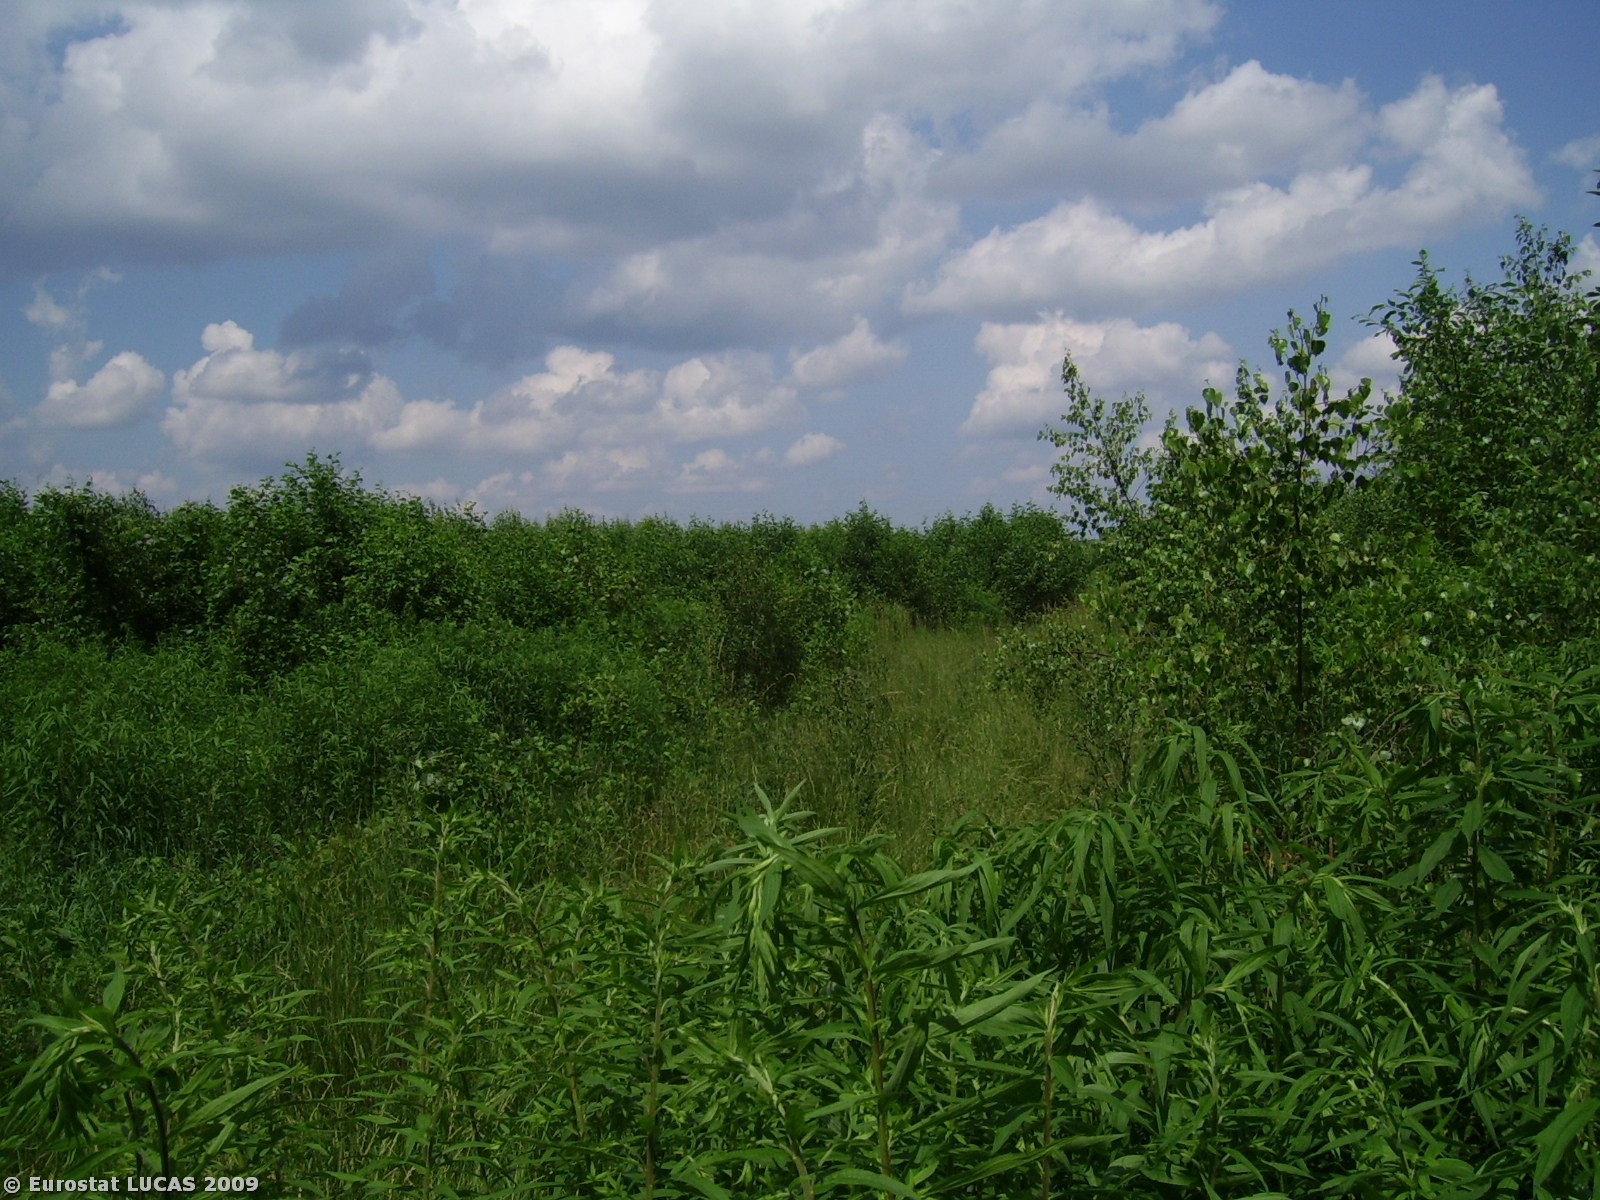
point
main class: Woodland
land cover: Broadleaved woodland
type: mesophytic deciduous forest
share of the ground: > 75 %
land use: Unused
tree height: > 5 m
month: July
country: PL
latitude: 53.2056
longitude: 18.0553
